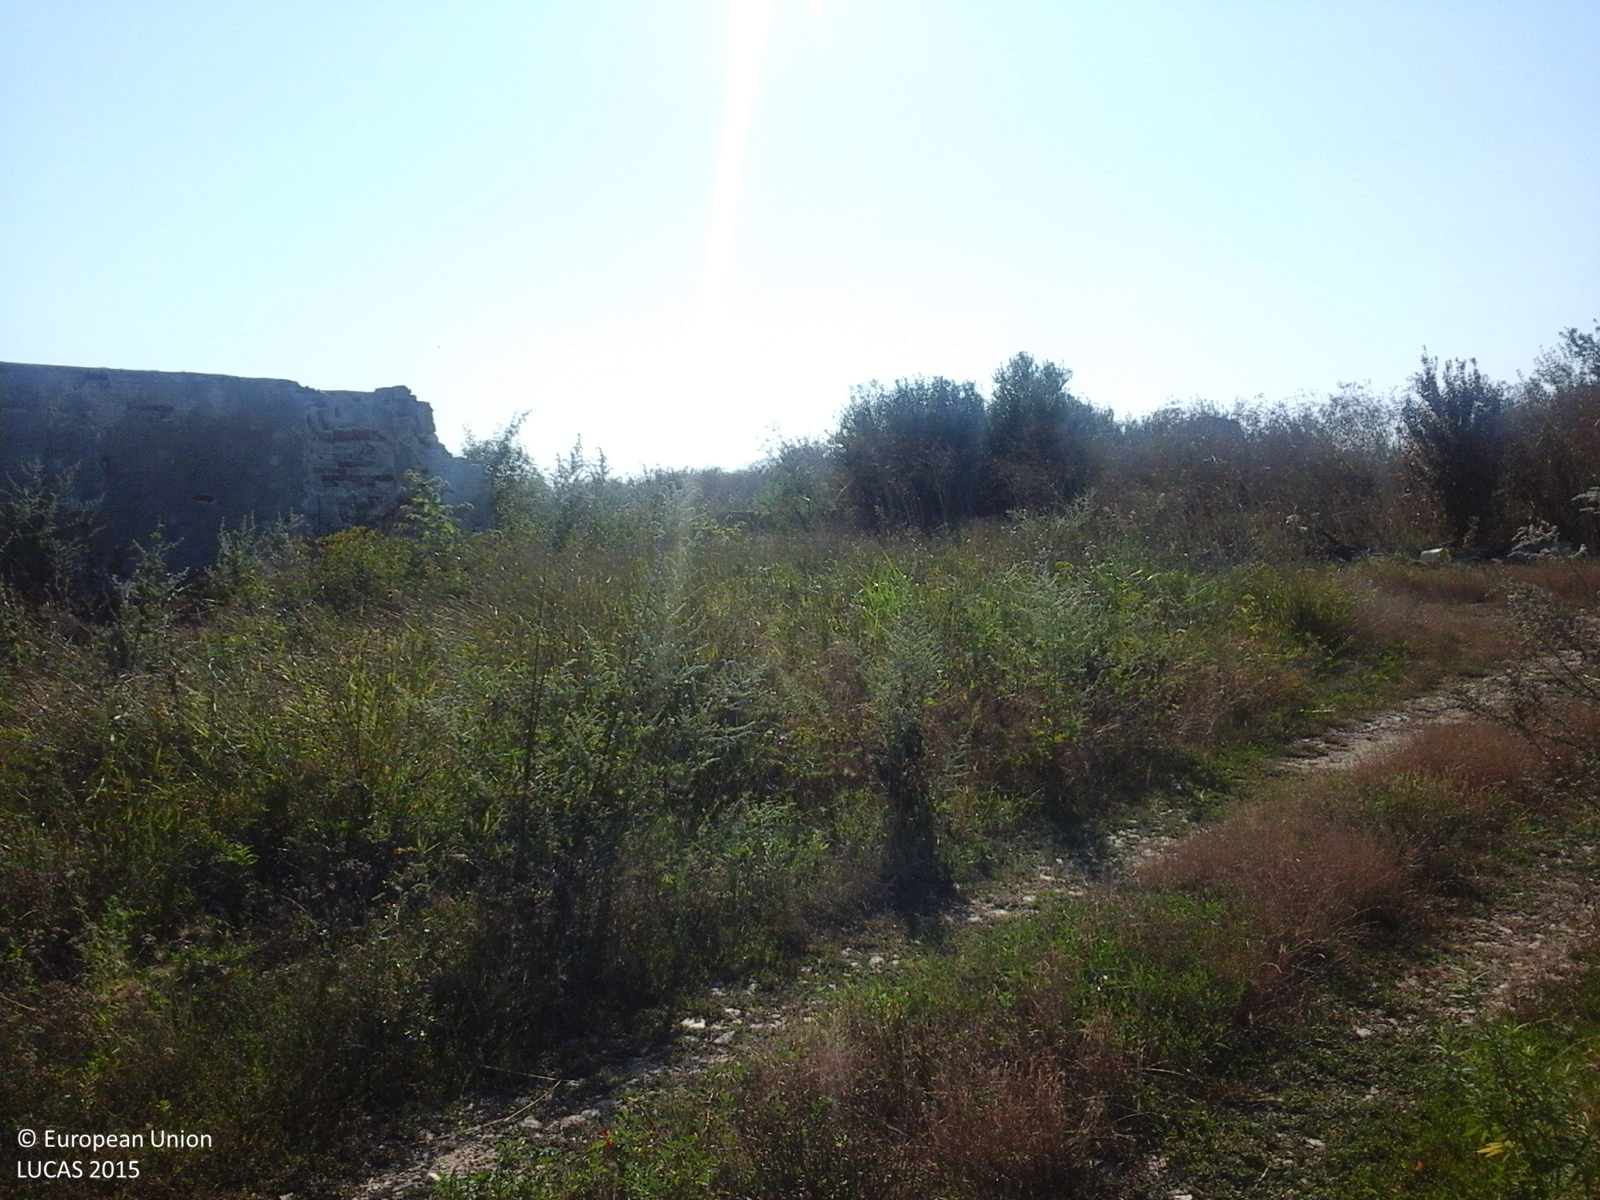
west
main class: Cropland
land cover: Common wheat
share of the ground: 10 - 25 %
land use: Agriculture (excluding fallow land and kitchen gardens)
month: August
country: RO
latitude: 44.2930
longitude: 28.5068
